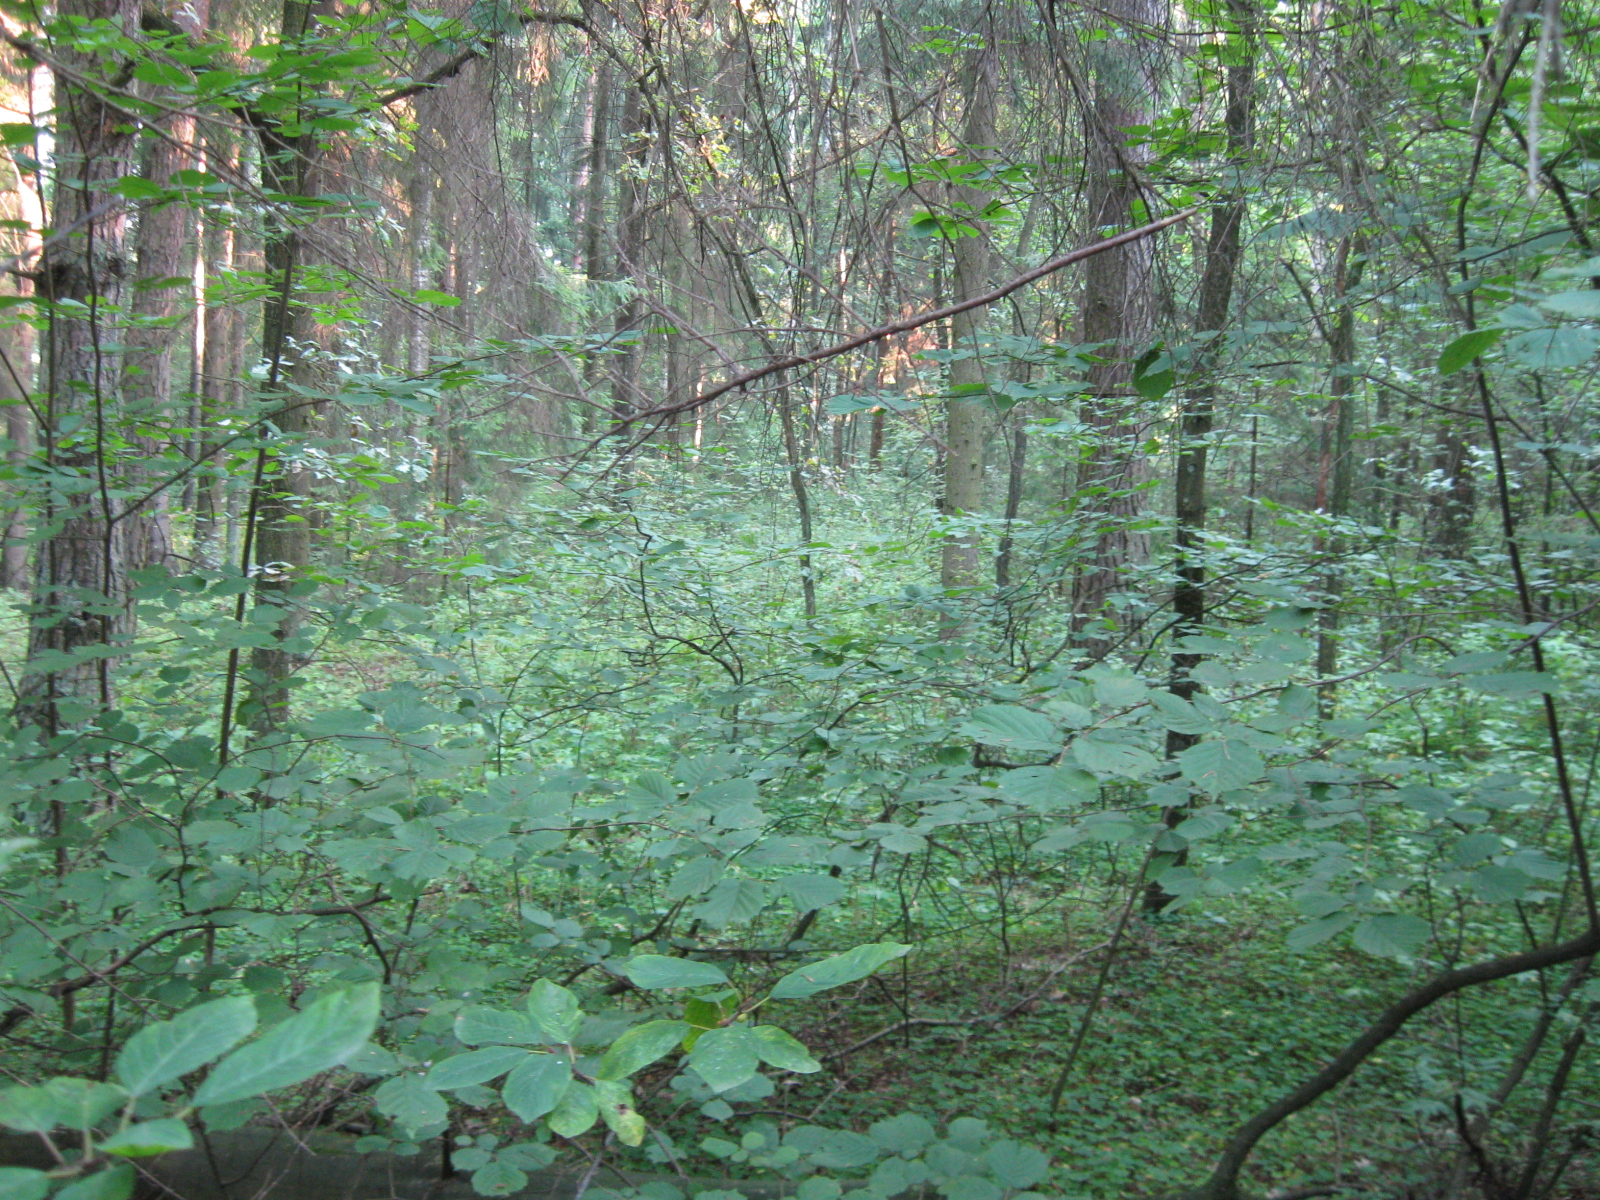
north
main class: Woodland
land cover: Other mixed woodland
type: hemiboreal forest and nemoral coniferous forest and mixed broadleaved-coniferous forest
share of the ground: > 75 %
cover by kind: coniferous forest trees 65 %, broadleaved forest trees 30 %, herbaceous plants 5 %
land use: Forestry
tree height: > 5 m
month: August
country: LT
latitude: 54.8107
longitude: 23.3507
